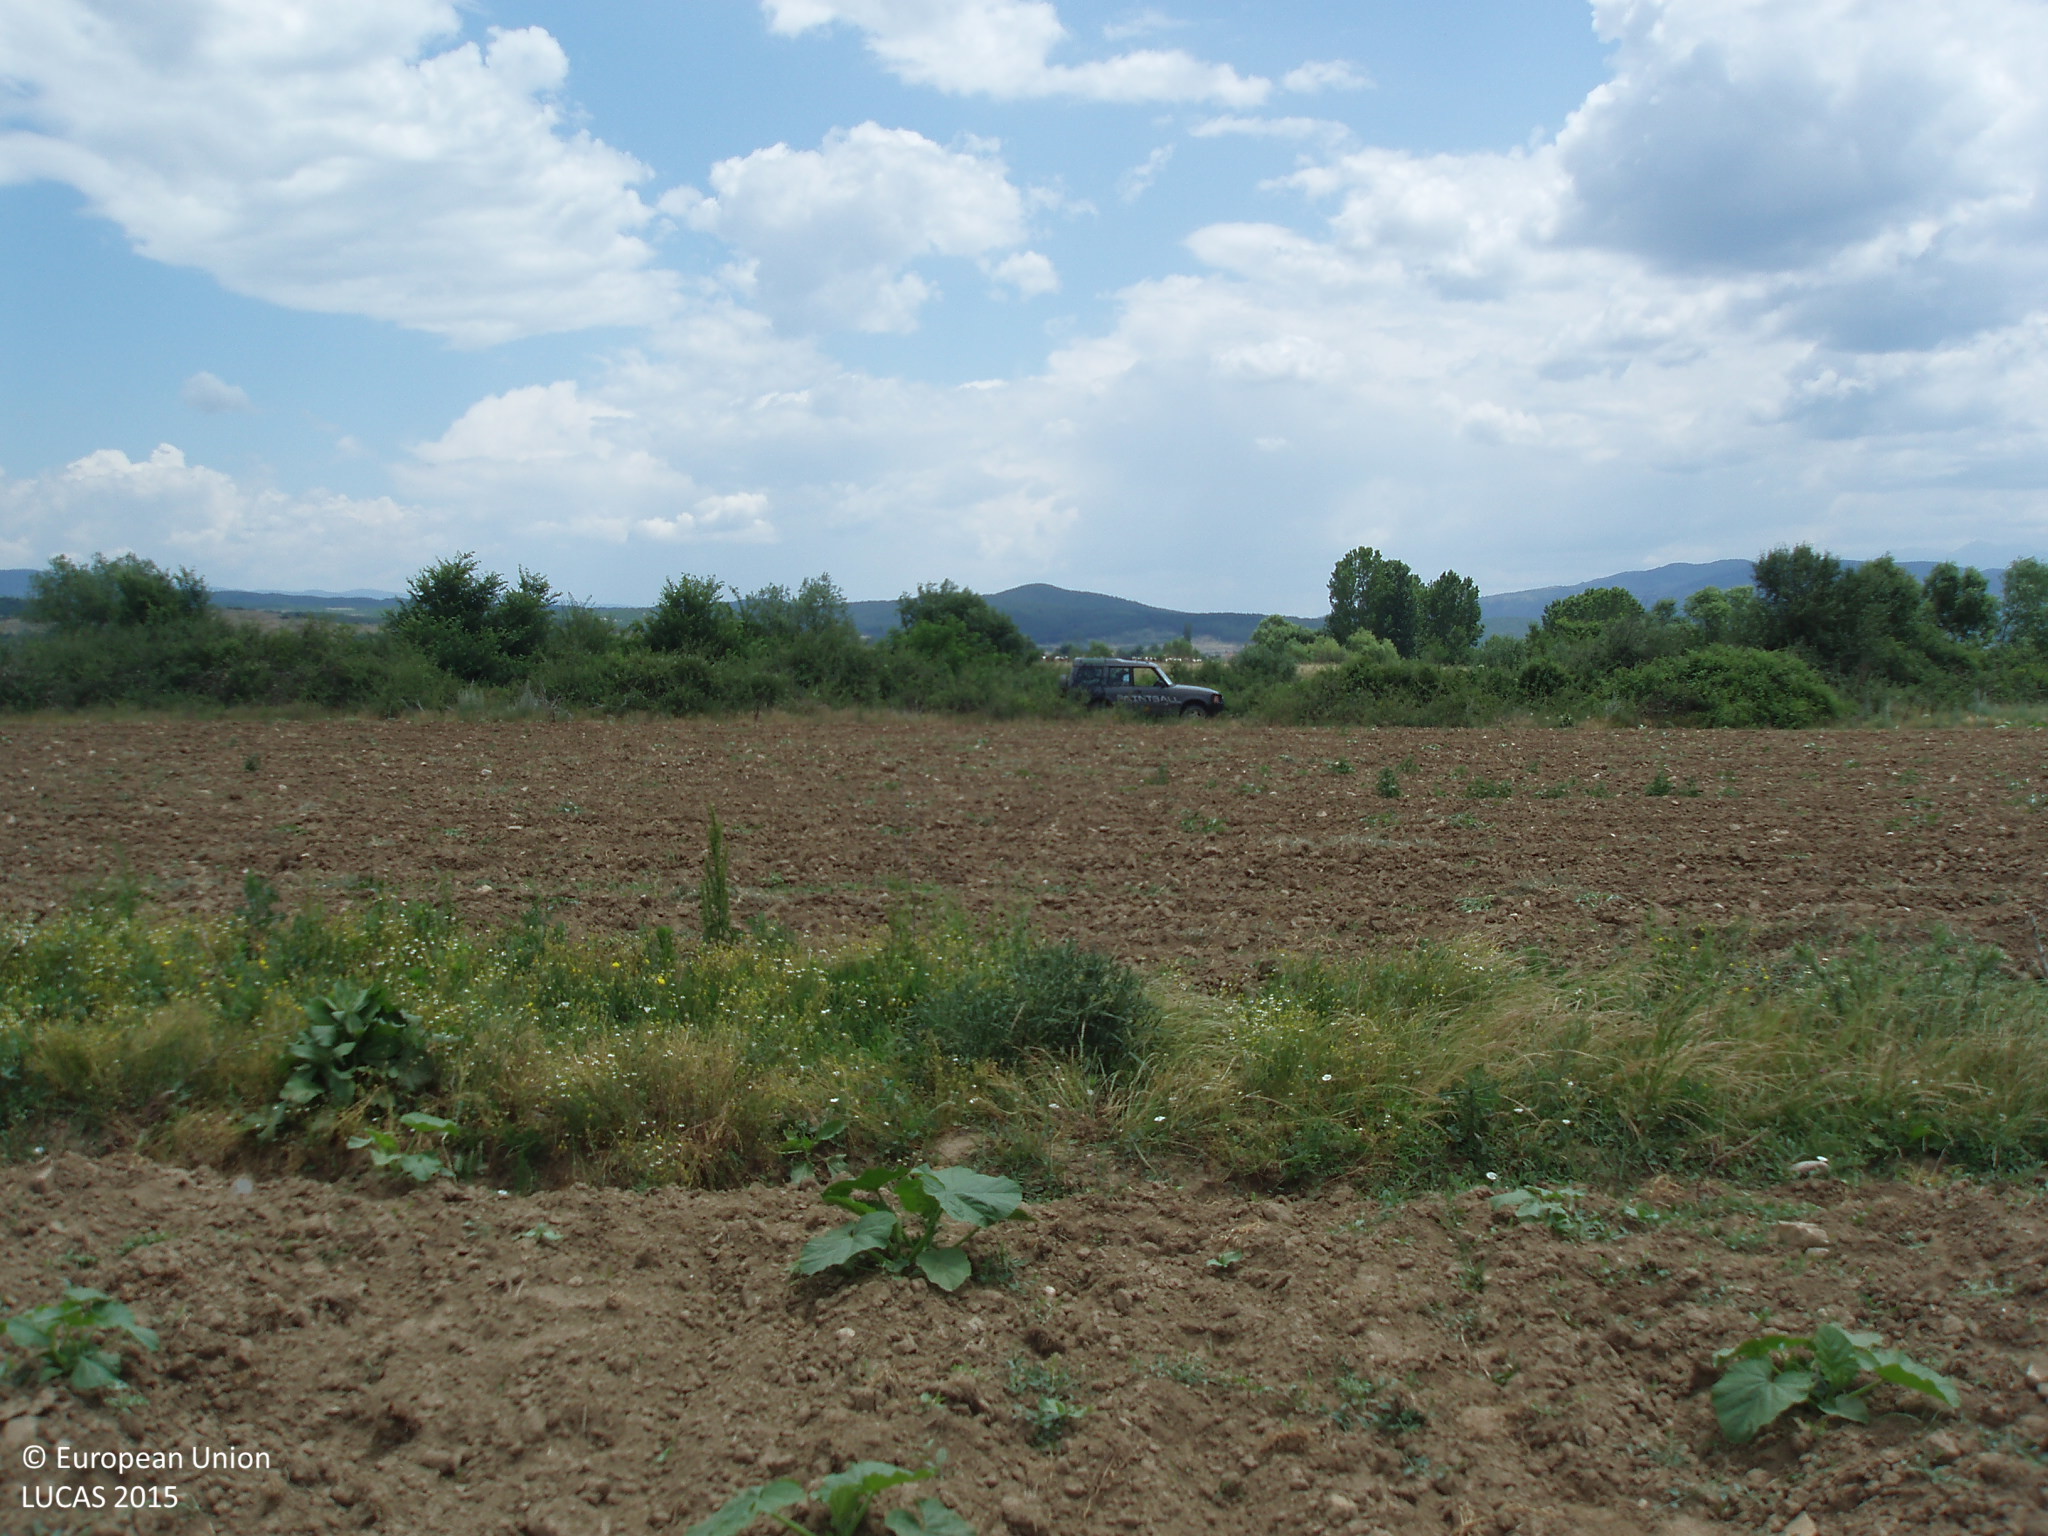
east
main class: Cropland
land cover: Other fresh vegetables
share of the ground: 25 - 50 %
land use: Agriculture (excluding fallow land and kitchen gardens)
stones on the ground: < 10 %
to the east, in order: Other fresh vegetables; Tracks; Other fresh vegetables; Tracks; Grassland without tree/shrub cover; Broadleaved woodland; Common wheat
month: June
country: BG
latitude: 41.5538
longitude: 23.8293
